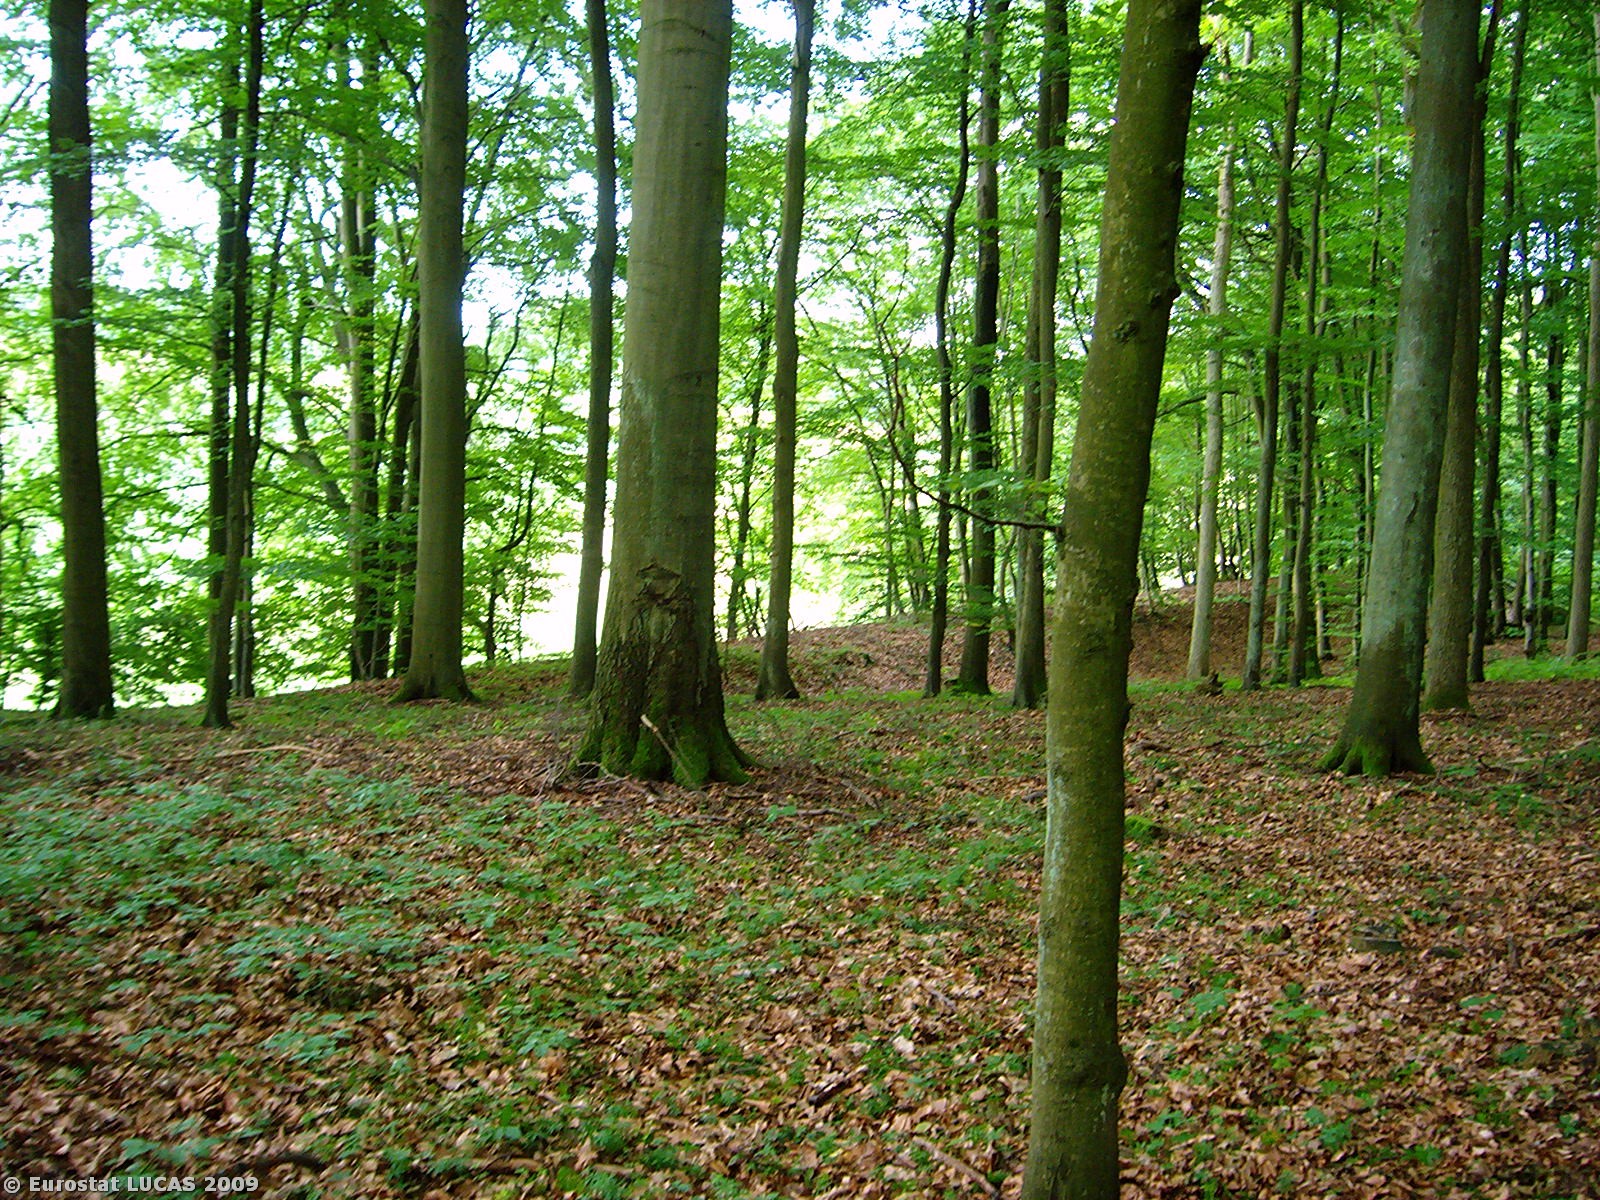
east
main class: Woodland
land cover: Broadleaved woodland
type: hemiboreal forest and nemoral coniferous forest and mixed broadleaved-coniferous forest
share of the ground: > 75 %
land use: Forestry
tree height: > 5 m
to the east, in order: Broadleaved woodland; Grassland without tree/shrub cover; Rivers and streams
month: July
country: PL
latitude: 53.3497
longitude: 15.4865
